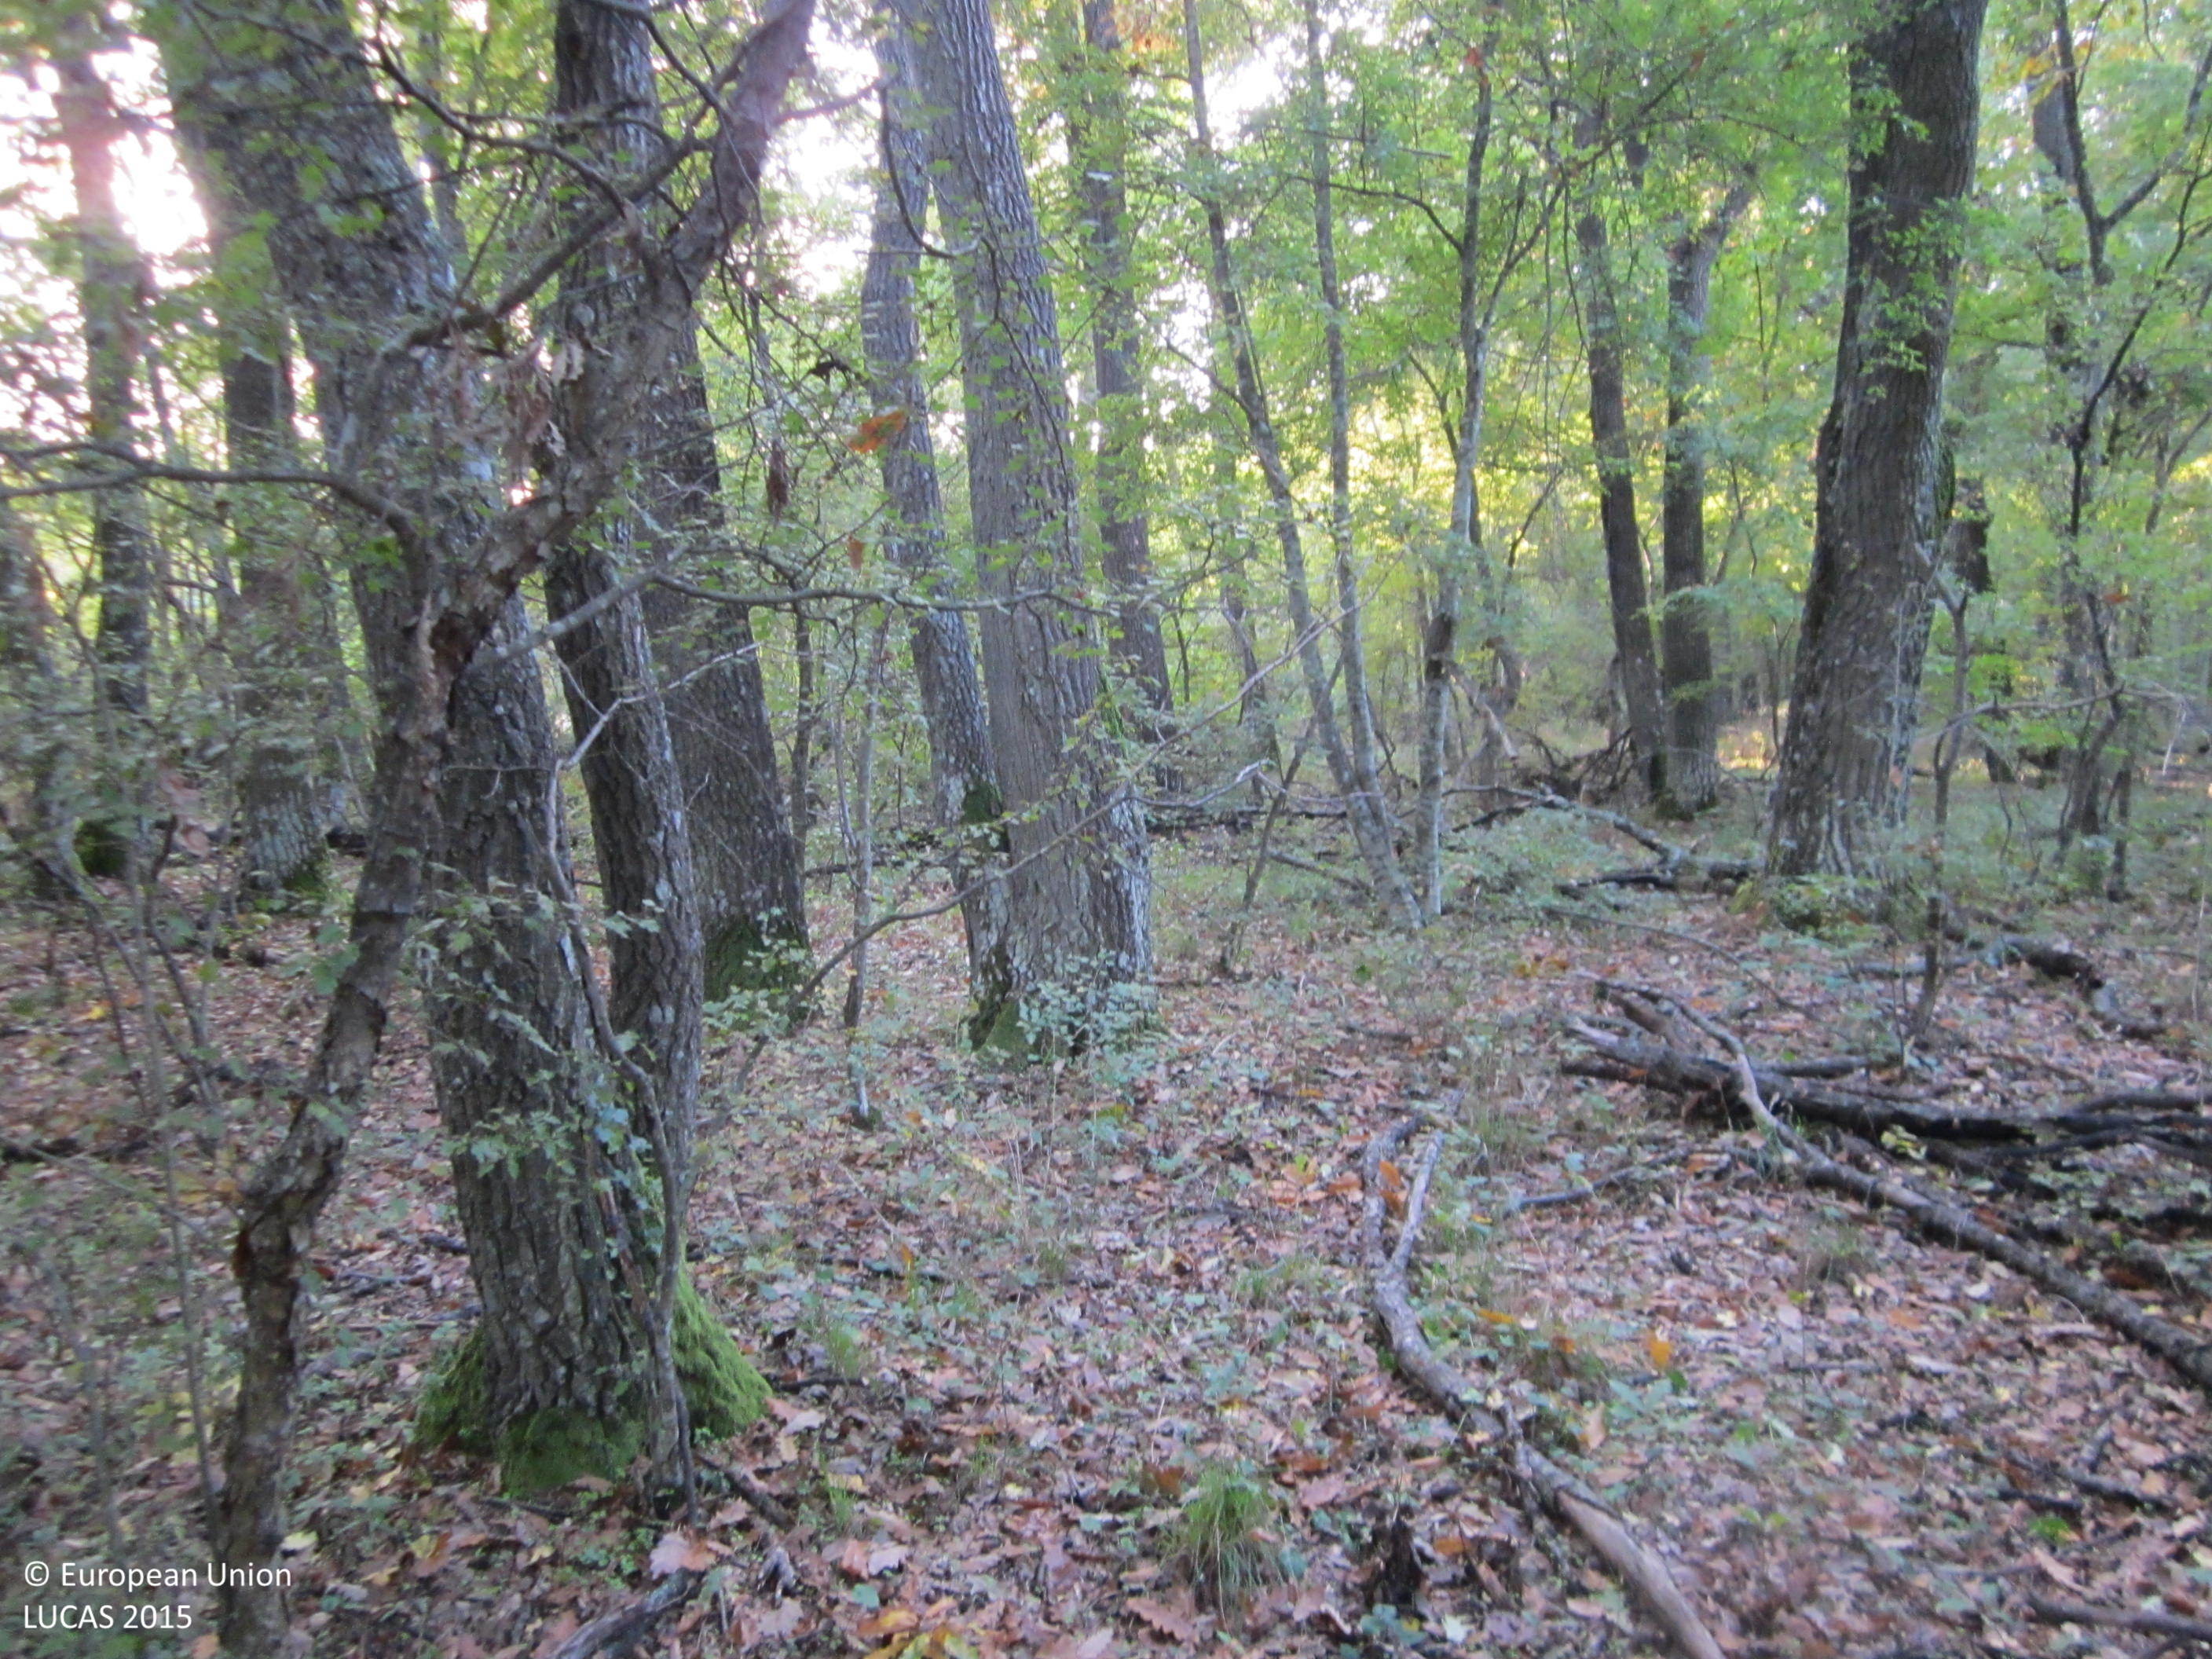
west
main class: Woodland
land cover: Broadleaved woodland
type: mesophytic deciduous forest
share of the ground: > 75 %
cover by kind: broadleaved forest trees 90 %, herbaceous plants 5 %, unconsolidated bare surface 5 %
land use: Forestry
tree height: > 5 m
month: October
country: BG
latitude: 42.1899
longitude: 27.2655
